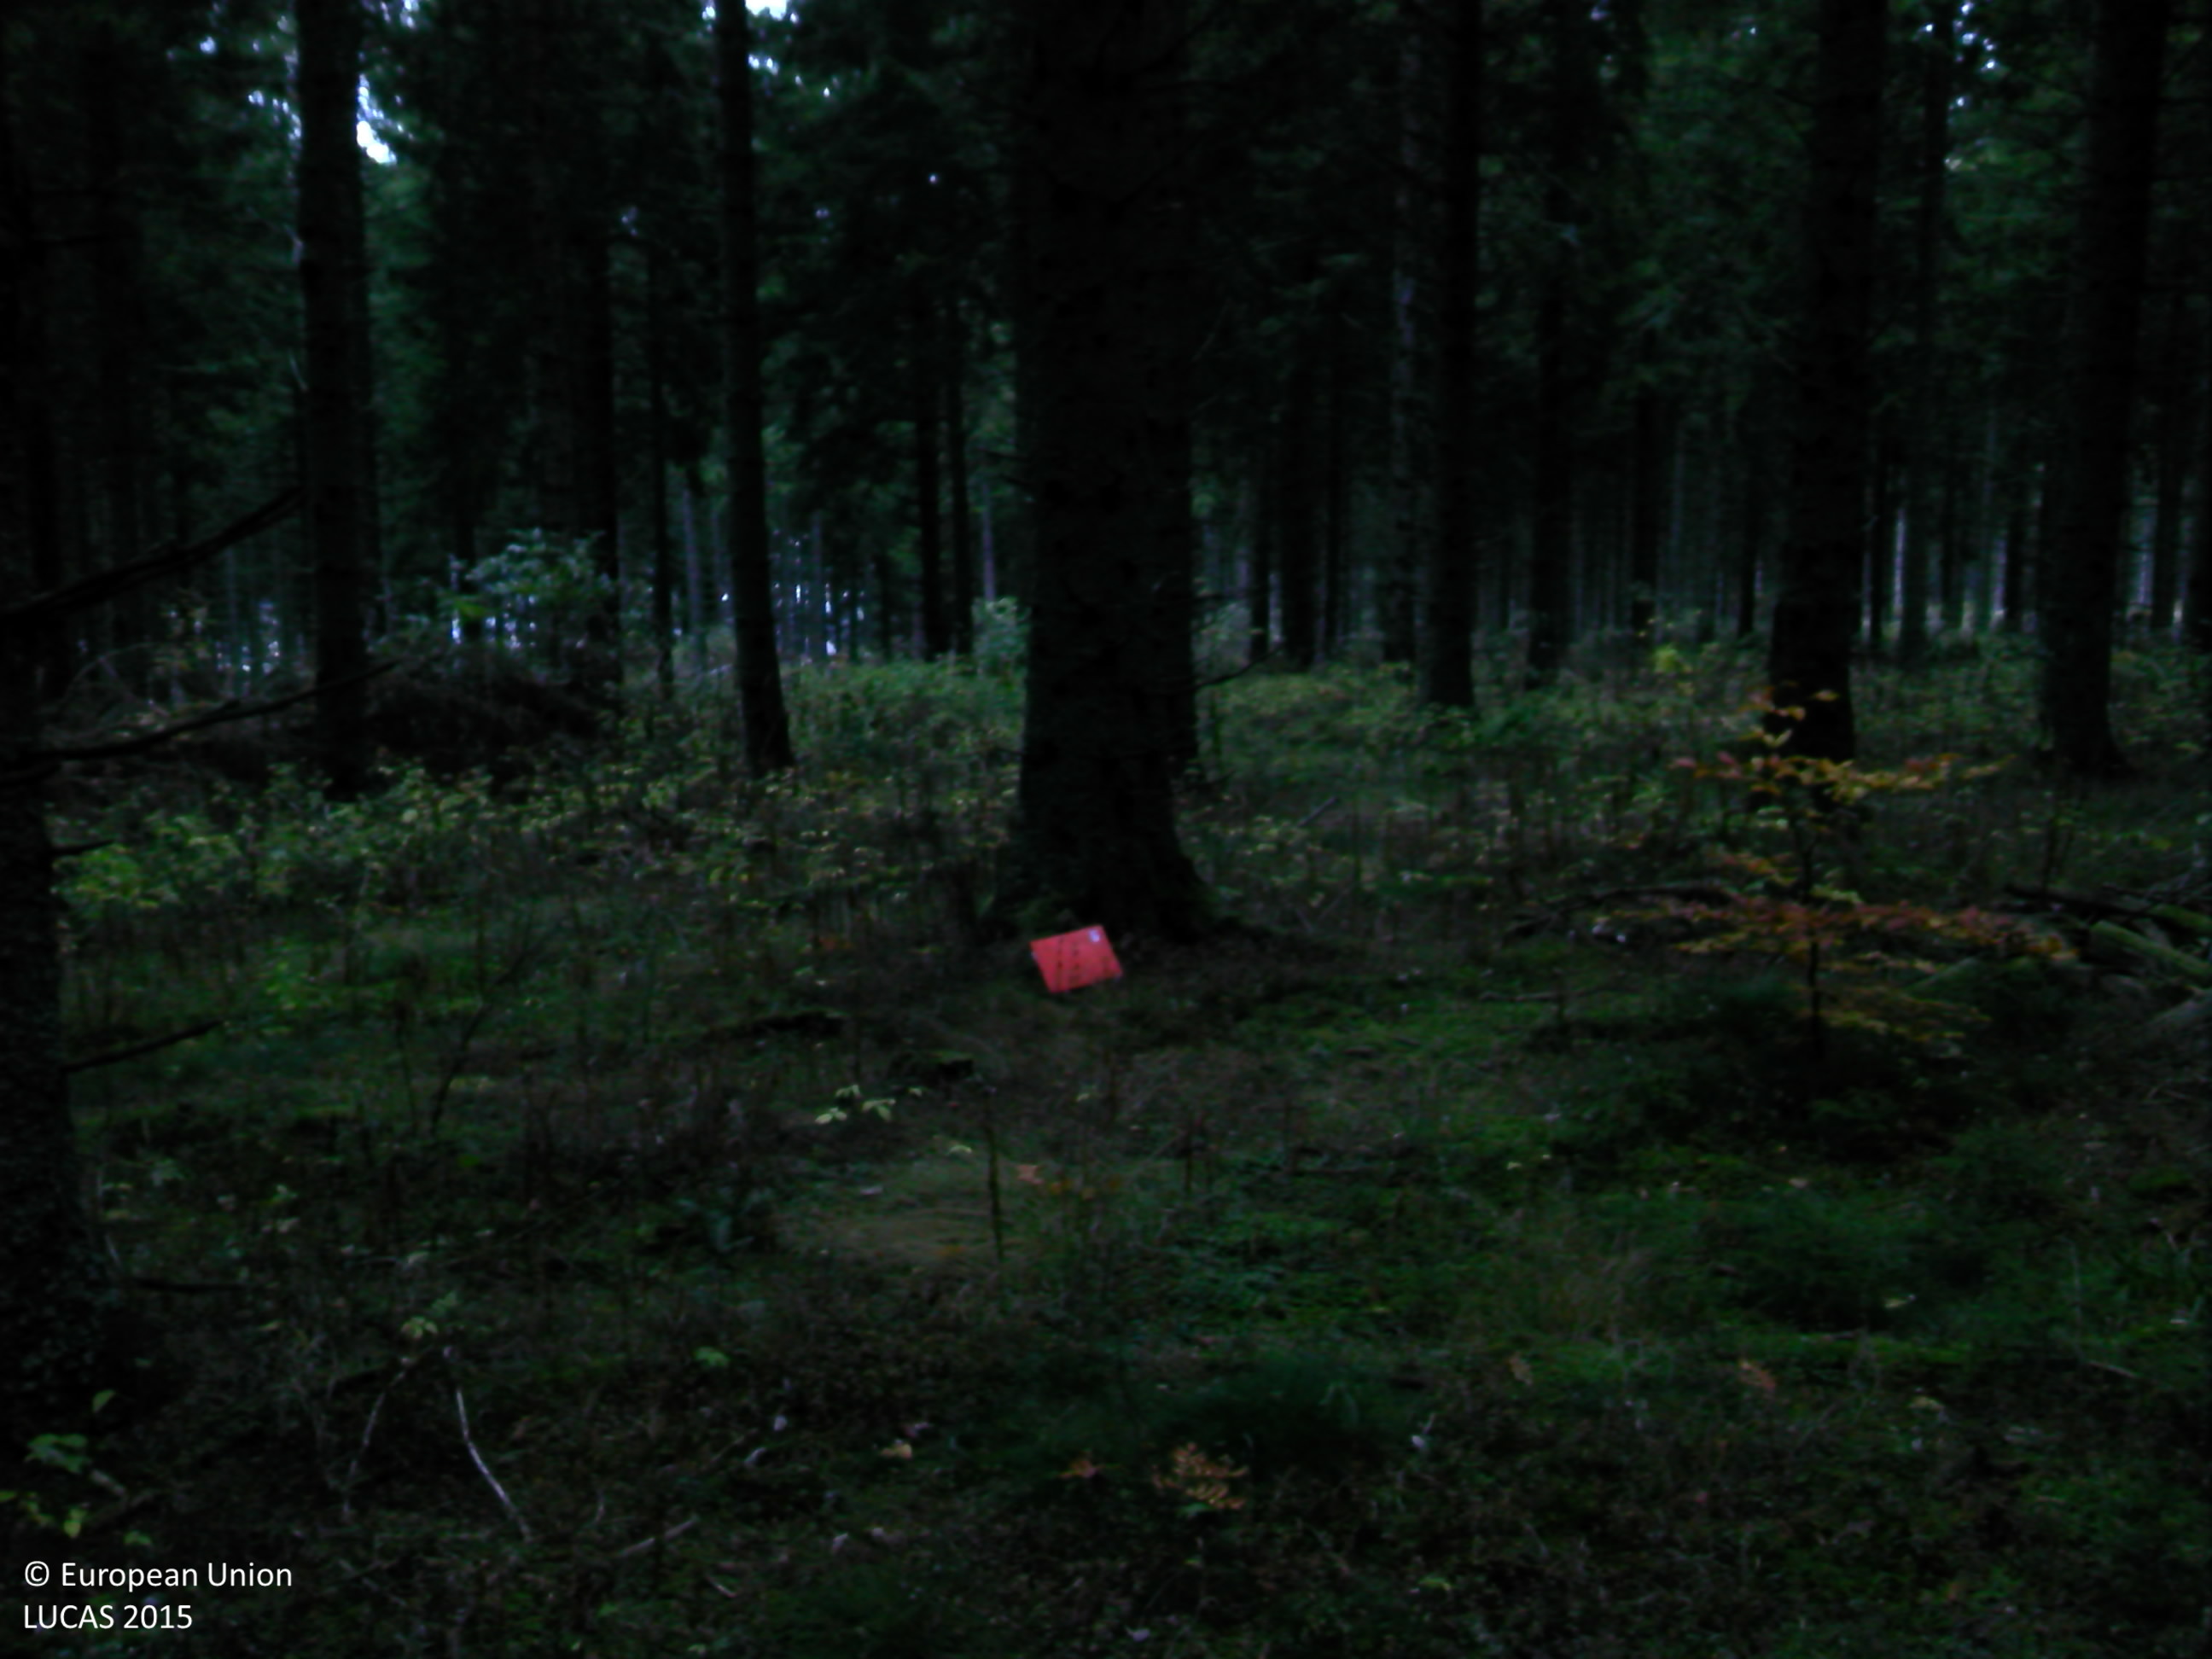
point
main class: Woodland
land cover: Spruce dominated coniferous woodland
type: exotic forest
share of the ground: > 75 %
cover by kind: coniferous forest trees 80 %, shrubs 10 %, herbaceous plants 5 %, lichens and mosses 5 %
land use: Forestry
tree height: > 5 m
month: October
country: FR
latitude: 44.7679
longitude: 3.9024
